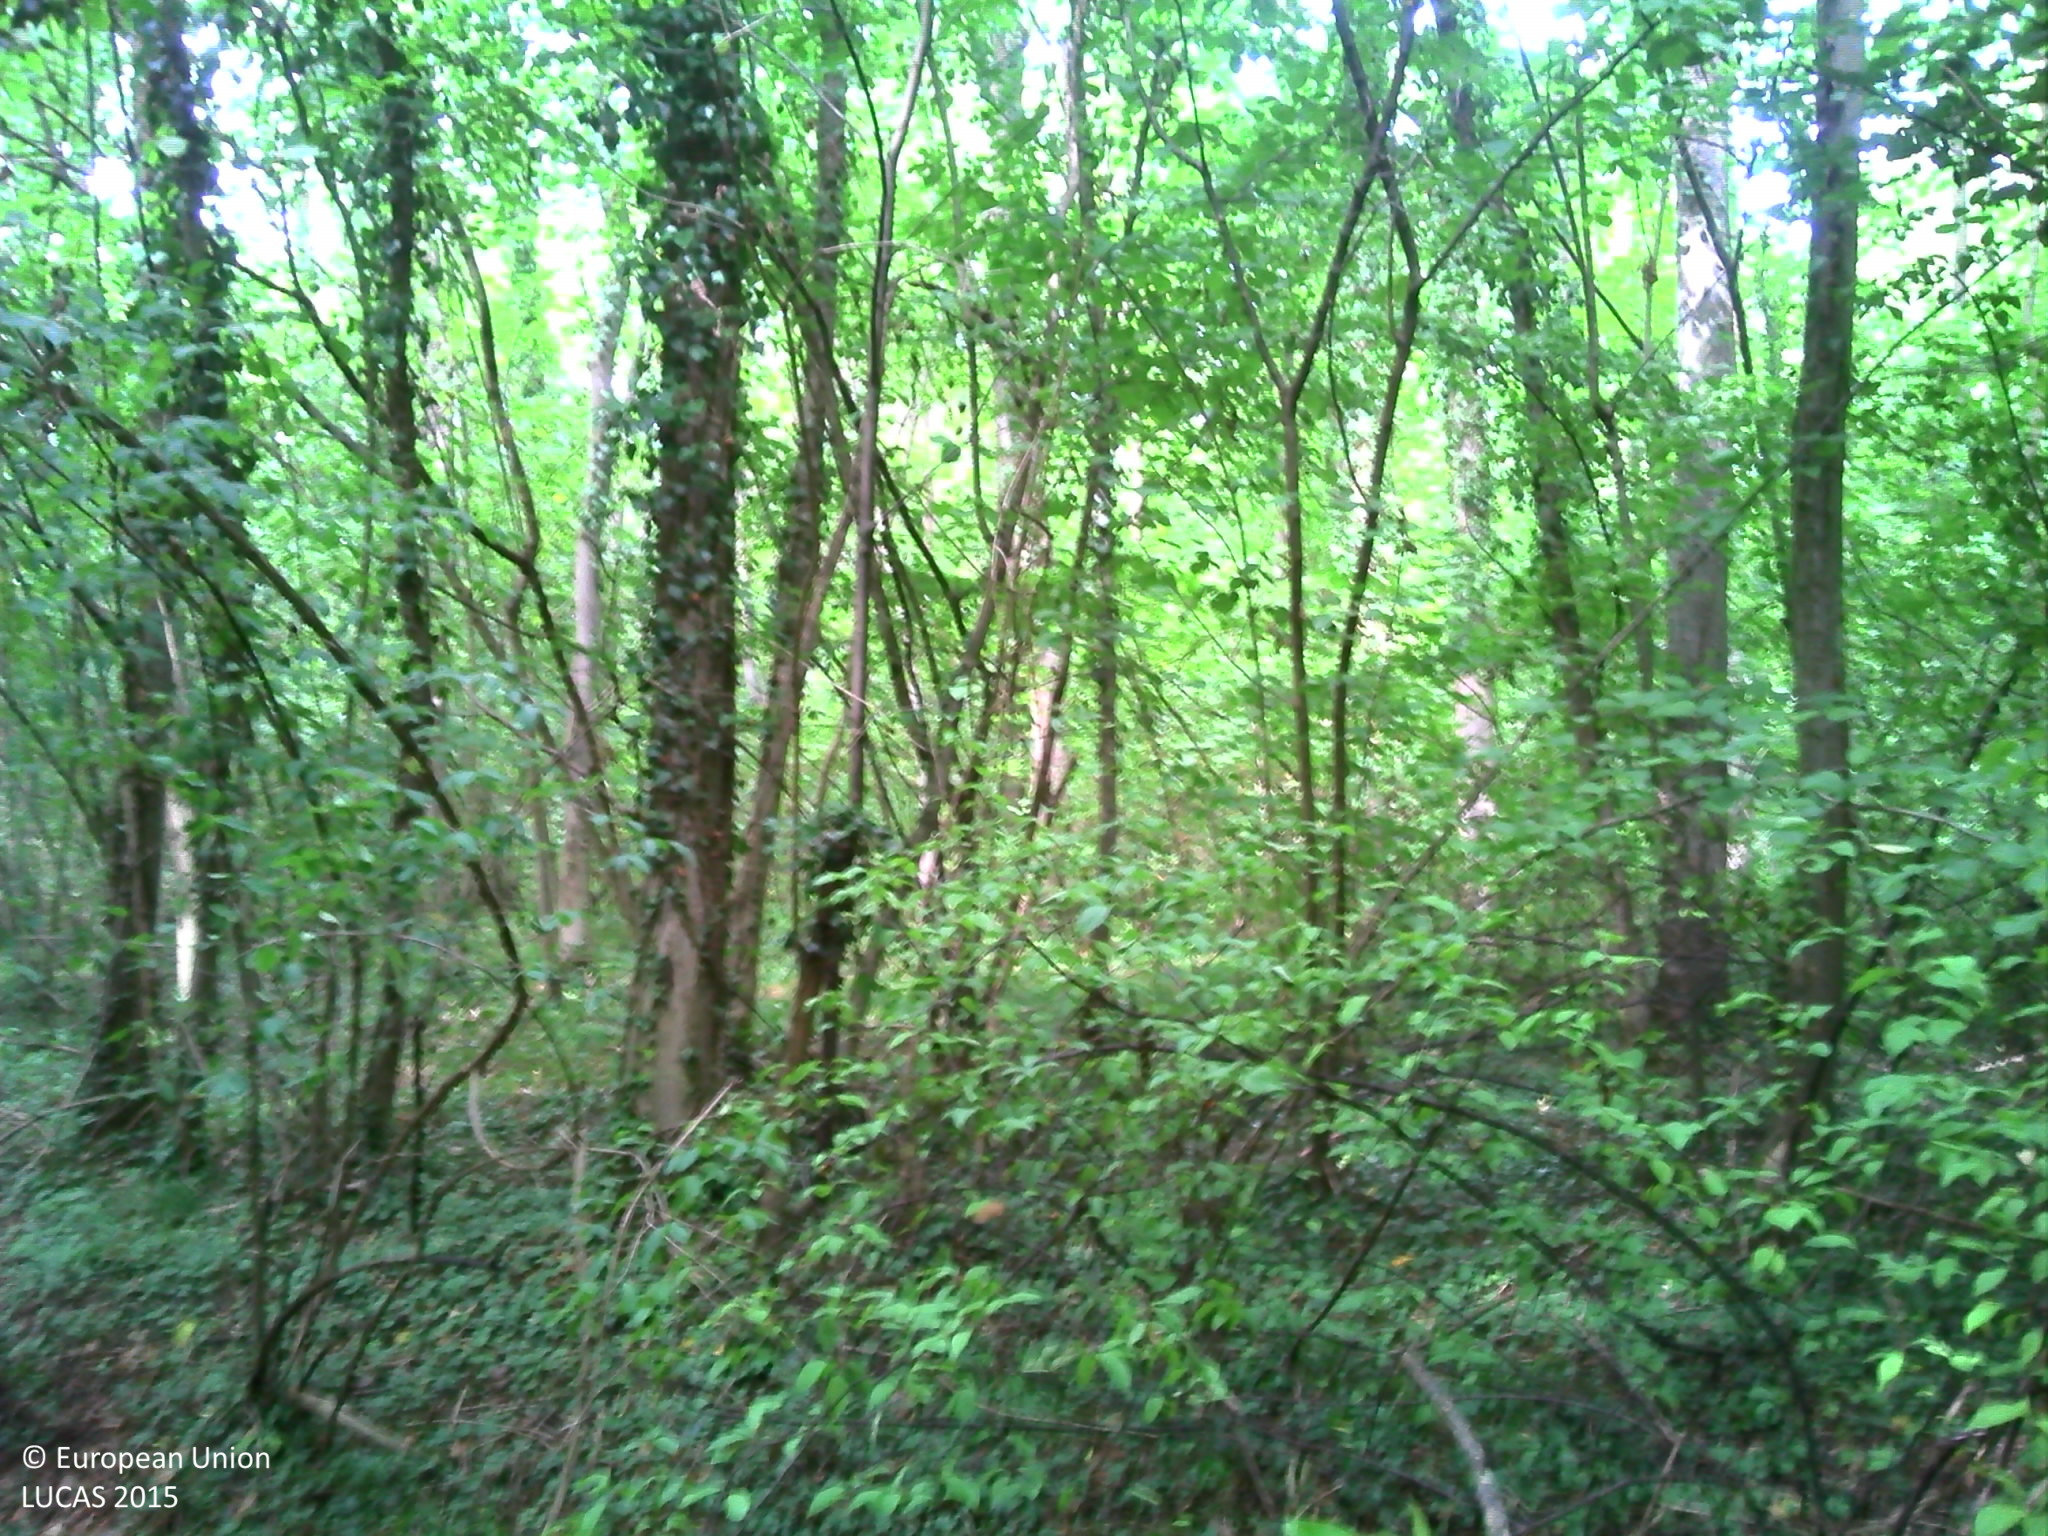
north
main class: Woodland
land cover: Broadleaved woodland
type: mesophytic deciduous forest
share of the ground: > 75 %
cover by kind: broadleaved forest trees 95 %, herbaceous plants 5 %
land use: Forestry
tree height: > 5 m
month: August
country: FR
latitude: 48.5064
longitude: 7.7404
